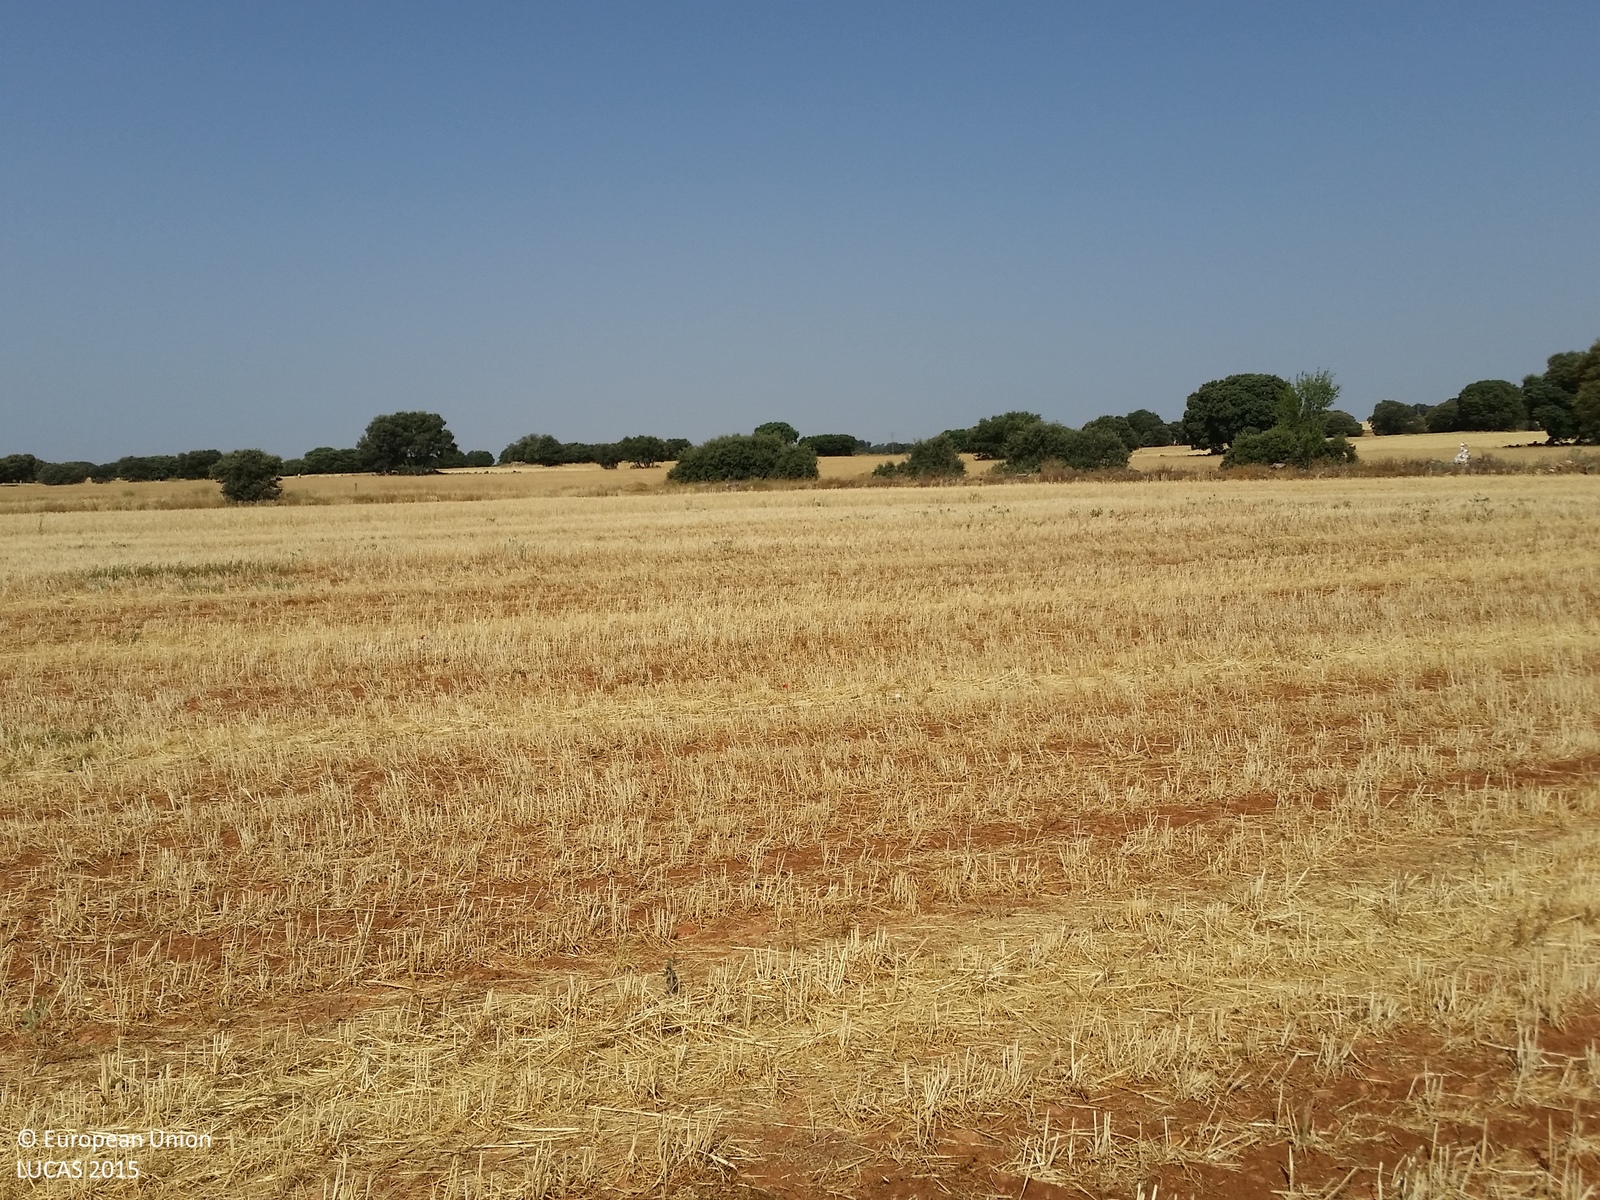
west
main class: Cropland
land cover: Barley
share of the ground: > 75 %
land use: Agriculture (excluding fallow land and kitchen gardens)
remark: Harvested field
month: June
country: ES
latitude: 38.7587
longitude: -2.5811
